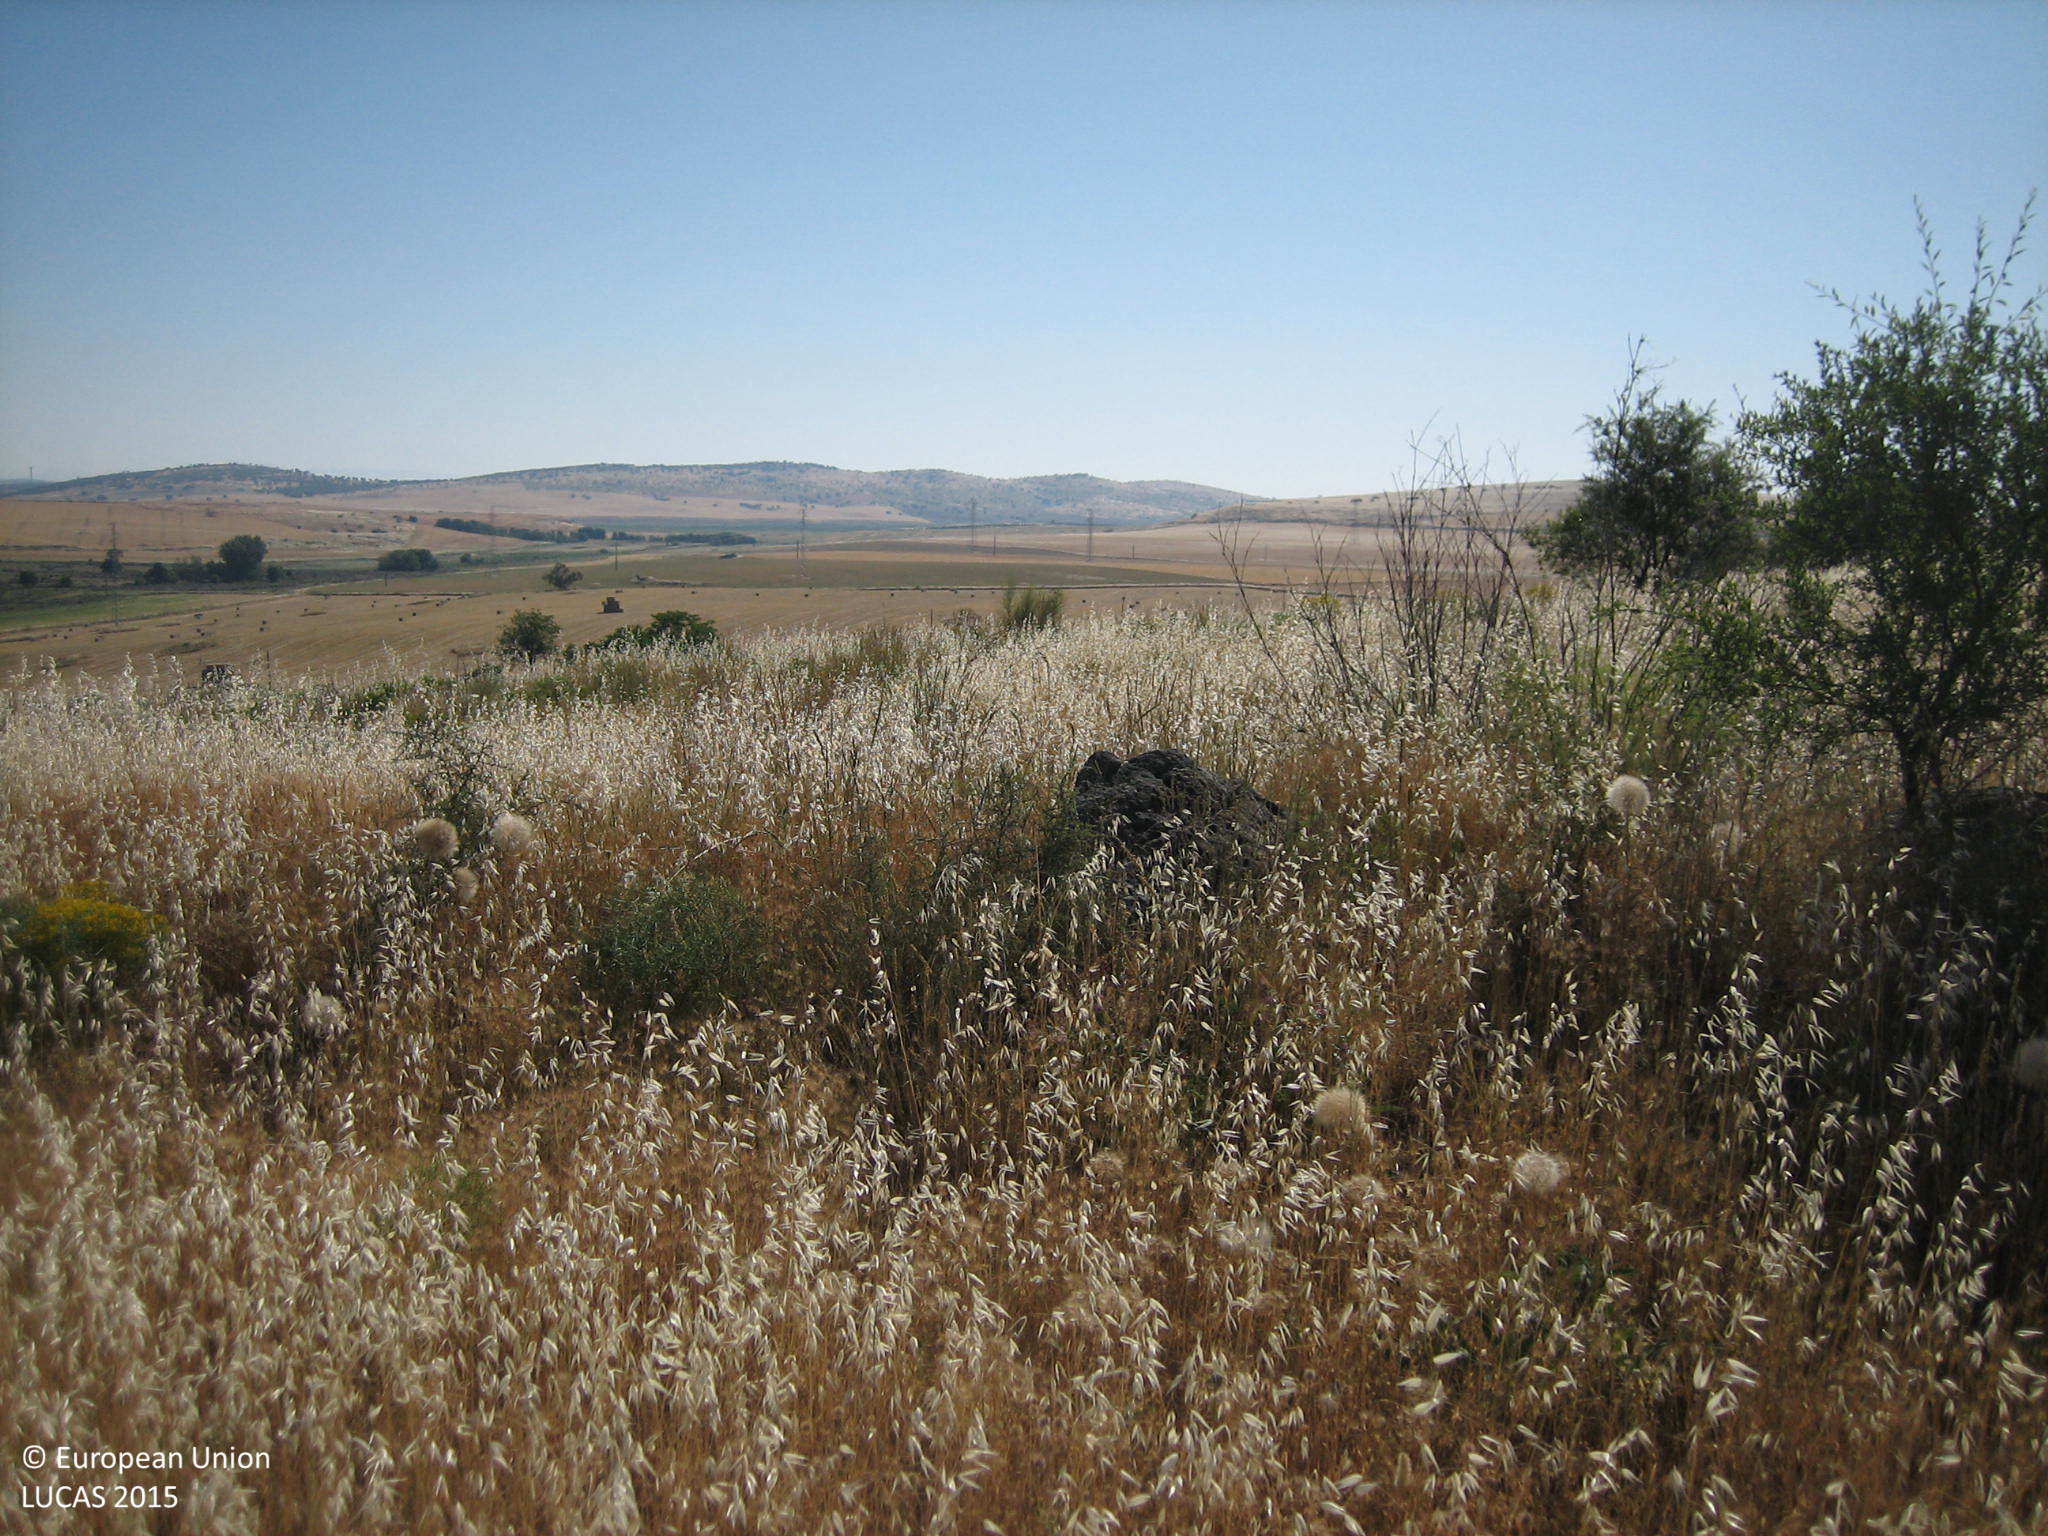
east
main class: Grassland
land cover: Spontaneously vegetated surfaces
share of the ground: > 75 %
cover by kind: herbaceous plants 95 %, shrubs 5 %
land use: Semi-natural and natural areas not in use
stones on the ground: < 10 %
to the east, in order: Spontaneously vegetated surfaces; Other bare soil
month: May
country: ES
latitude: 38.9906
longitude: -4.0729
